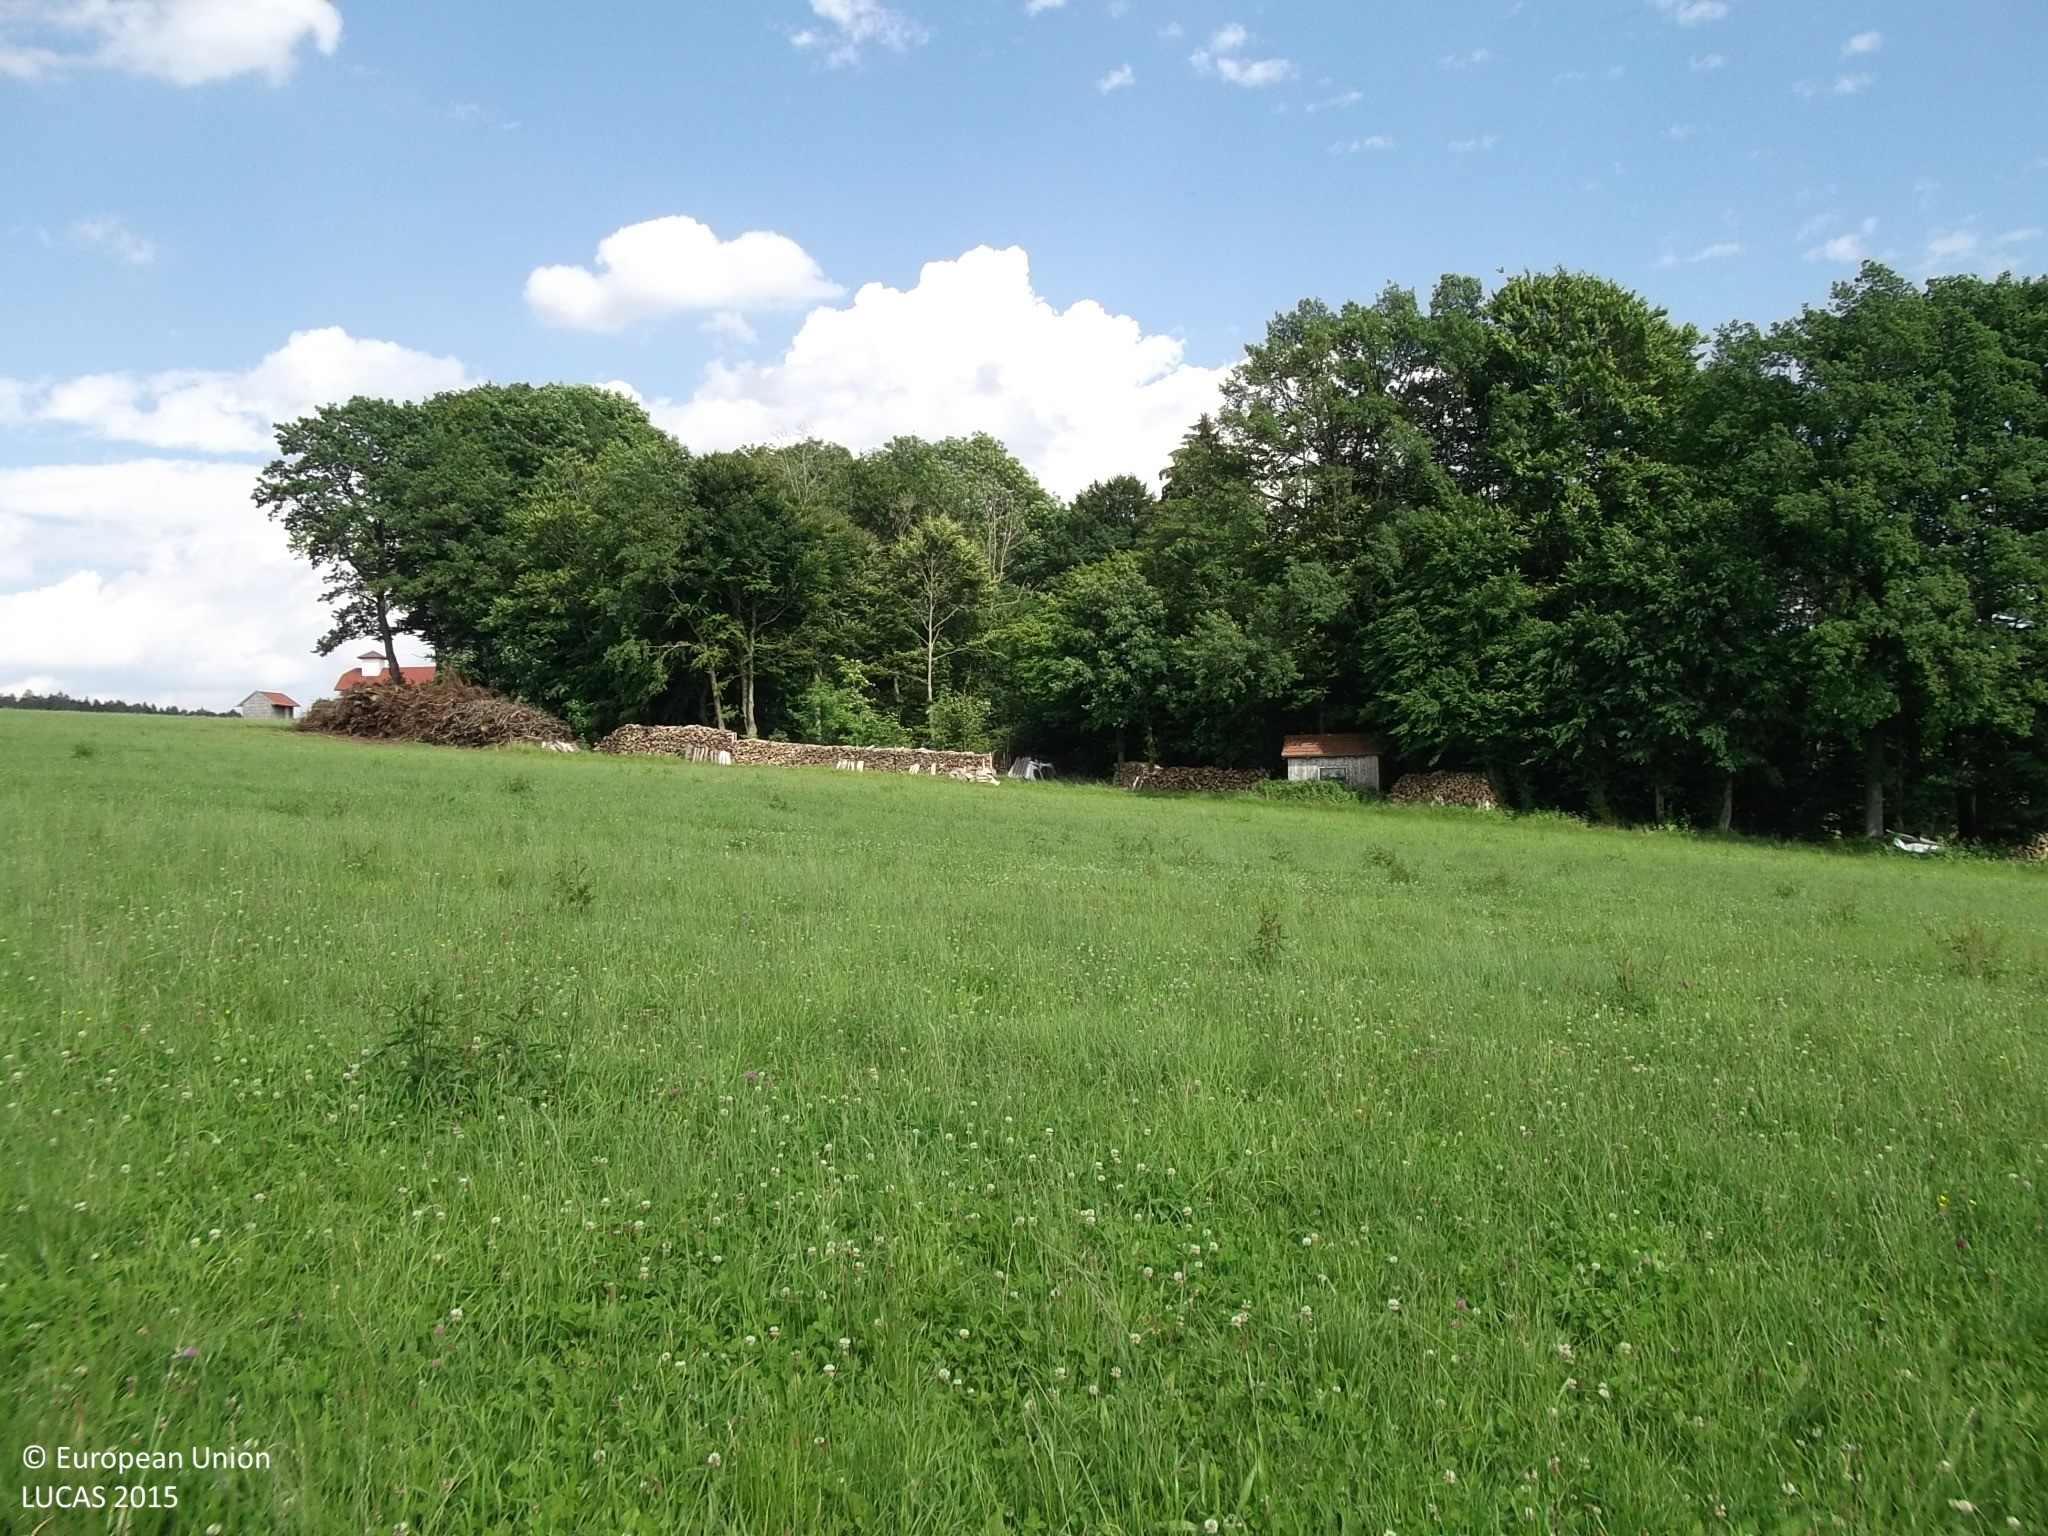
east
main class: Grassland
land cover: Grassland without tree/shrub cover
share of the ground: > 75 %
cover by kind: herbaceous plants 100 %
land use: Agriculture (excluding fallow land and kitchen gardens)
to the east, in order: Grassland without tree/shrub cover; Broadleaved woodland; Rivers and streams; Broadleaved woodland; Rivers and streams; Broadleaved woodland; Spruce dominated mixed woodland; Grassland without tree/shrub cover; Maize
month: June
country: AT
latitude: 48.0110
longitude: 13.3369
